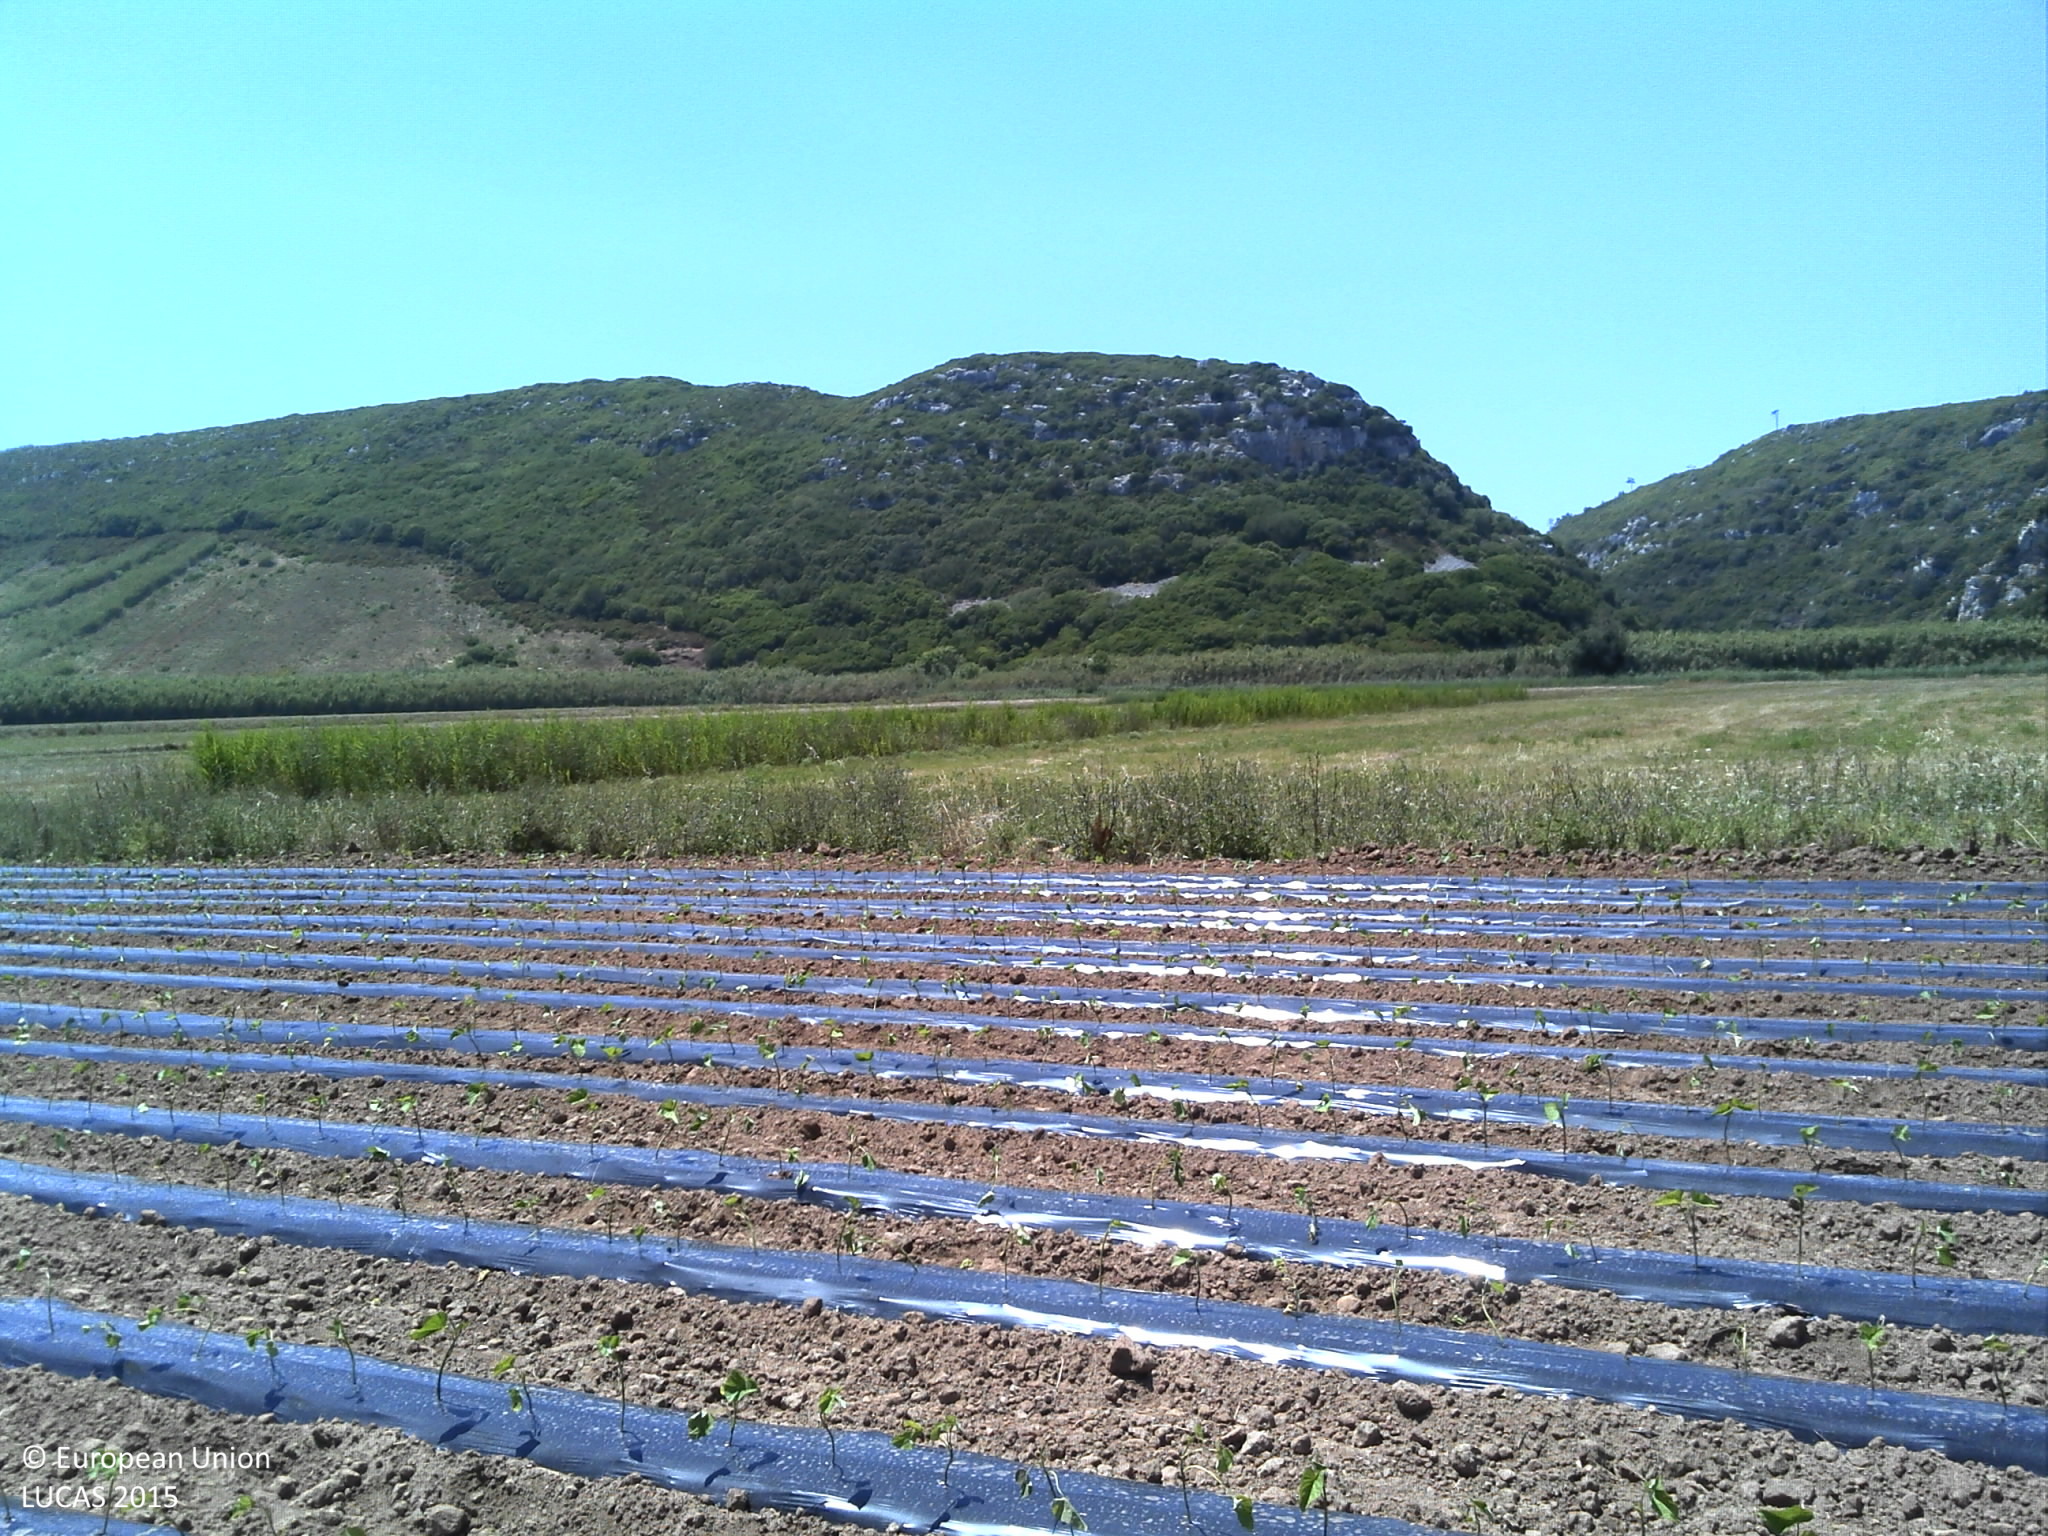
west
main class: Cropland
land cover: Other root crops
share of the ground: 10 - 25 %
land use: Agriculture (excluding fallow land and kitchen gardens)
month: June
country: PT
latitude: 39.1750
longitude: -9.3401
